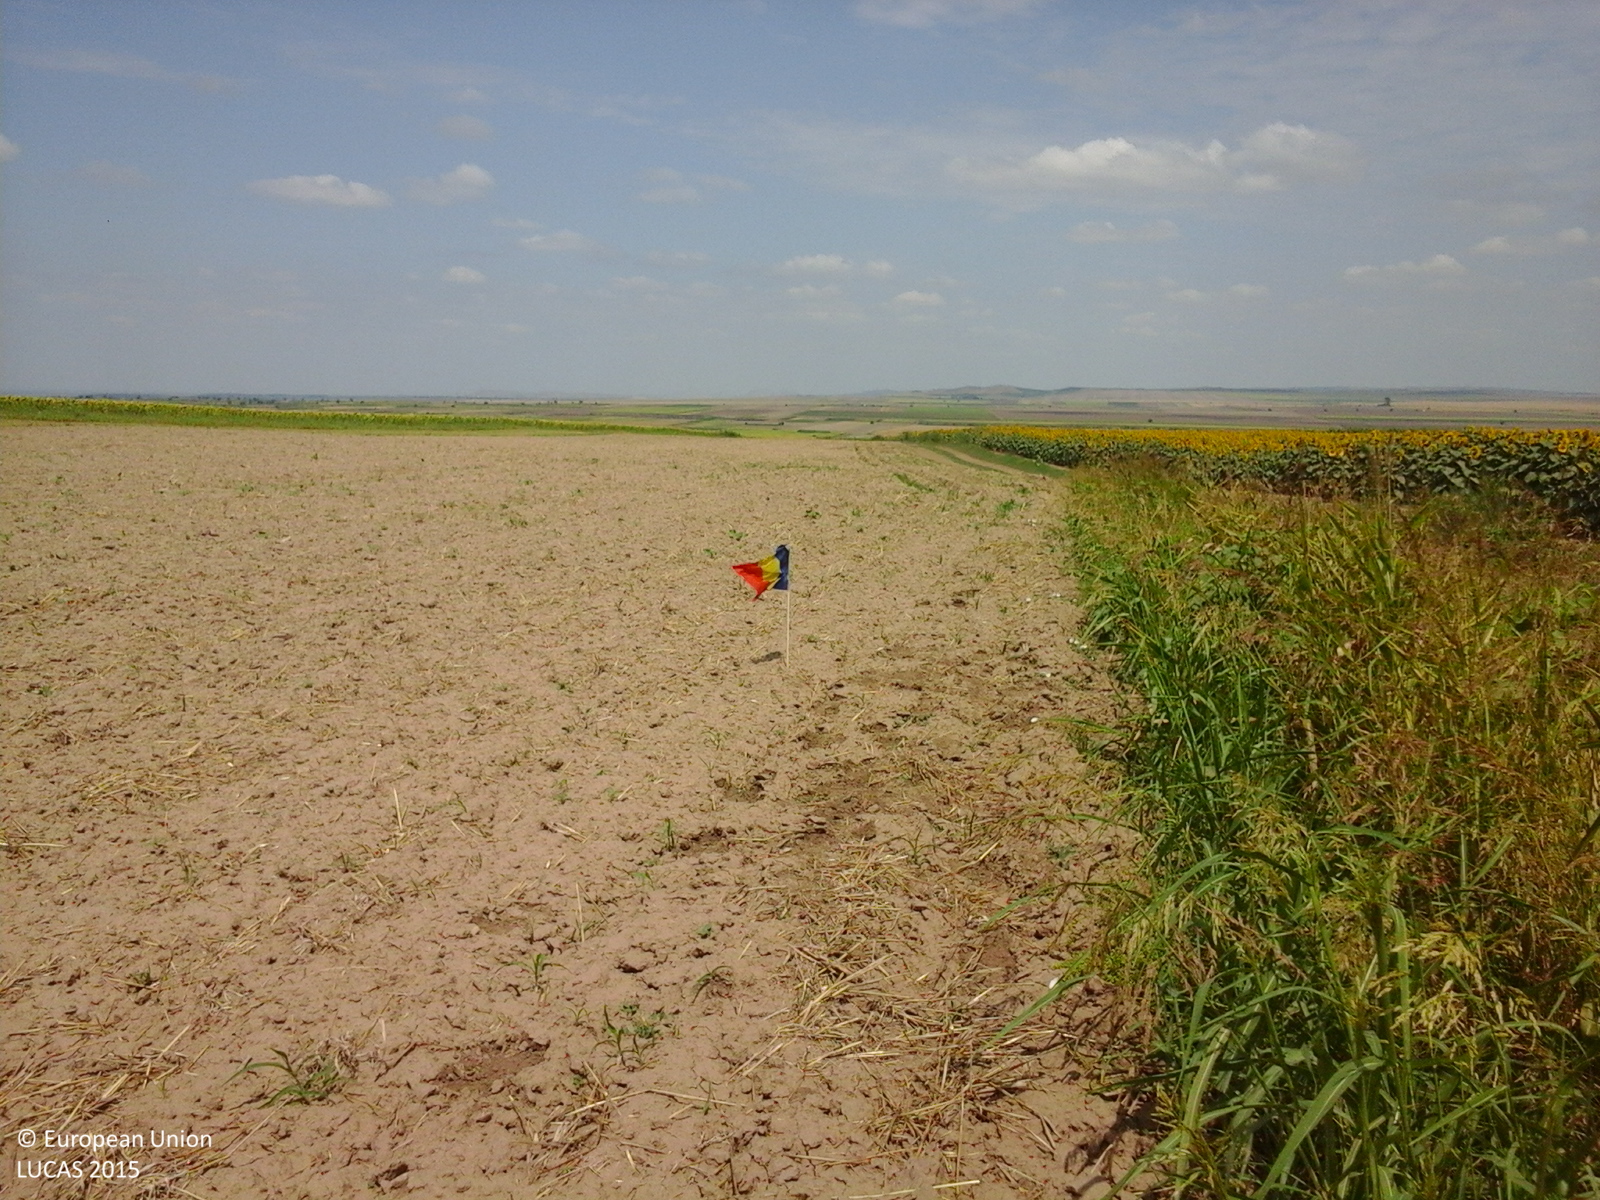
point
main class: Cropland
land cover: Common wheat
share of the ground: < 10 %
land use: Agriculture (excluding fallow land and kitchen gardens)
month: August
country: RO
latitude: 44.8163
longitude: 28.1611
